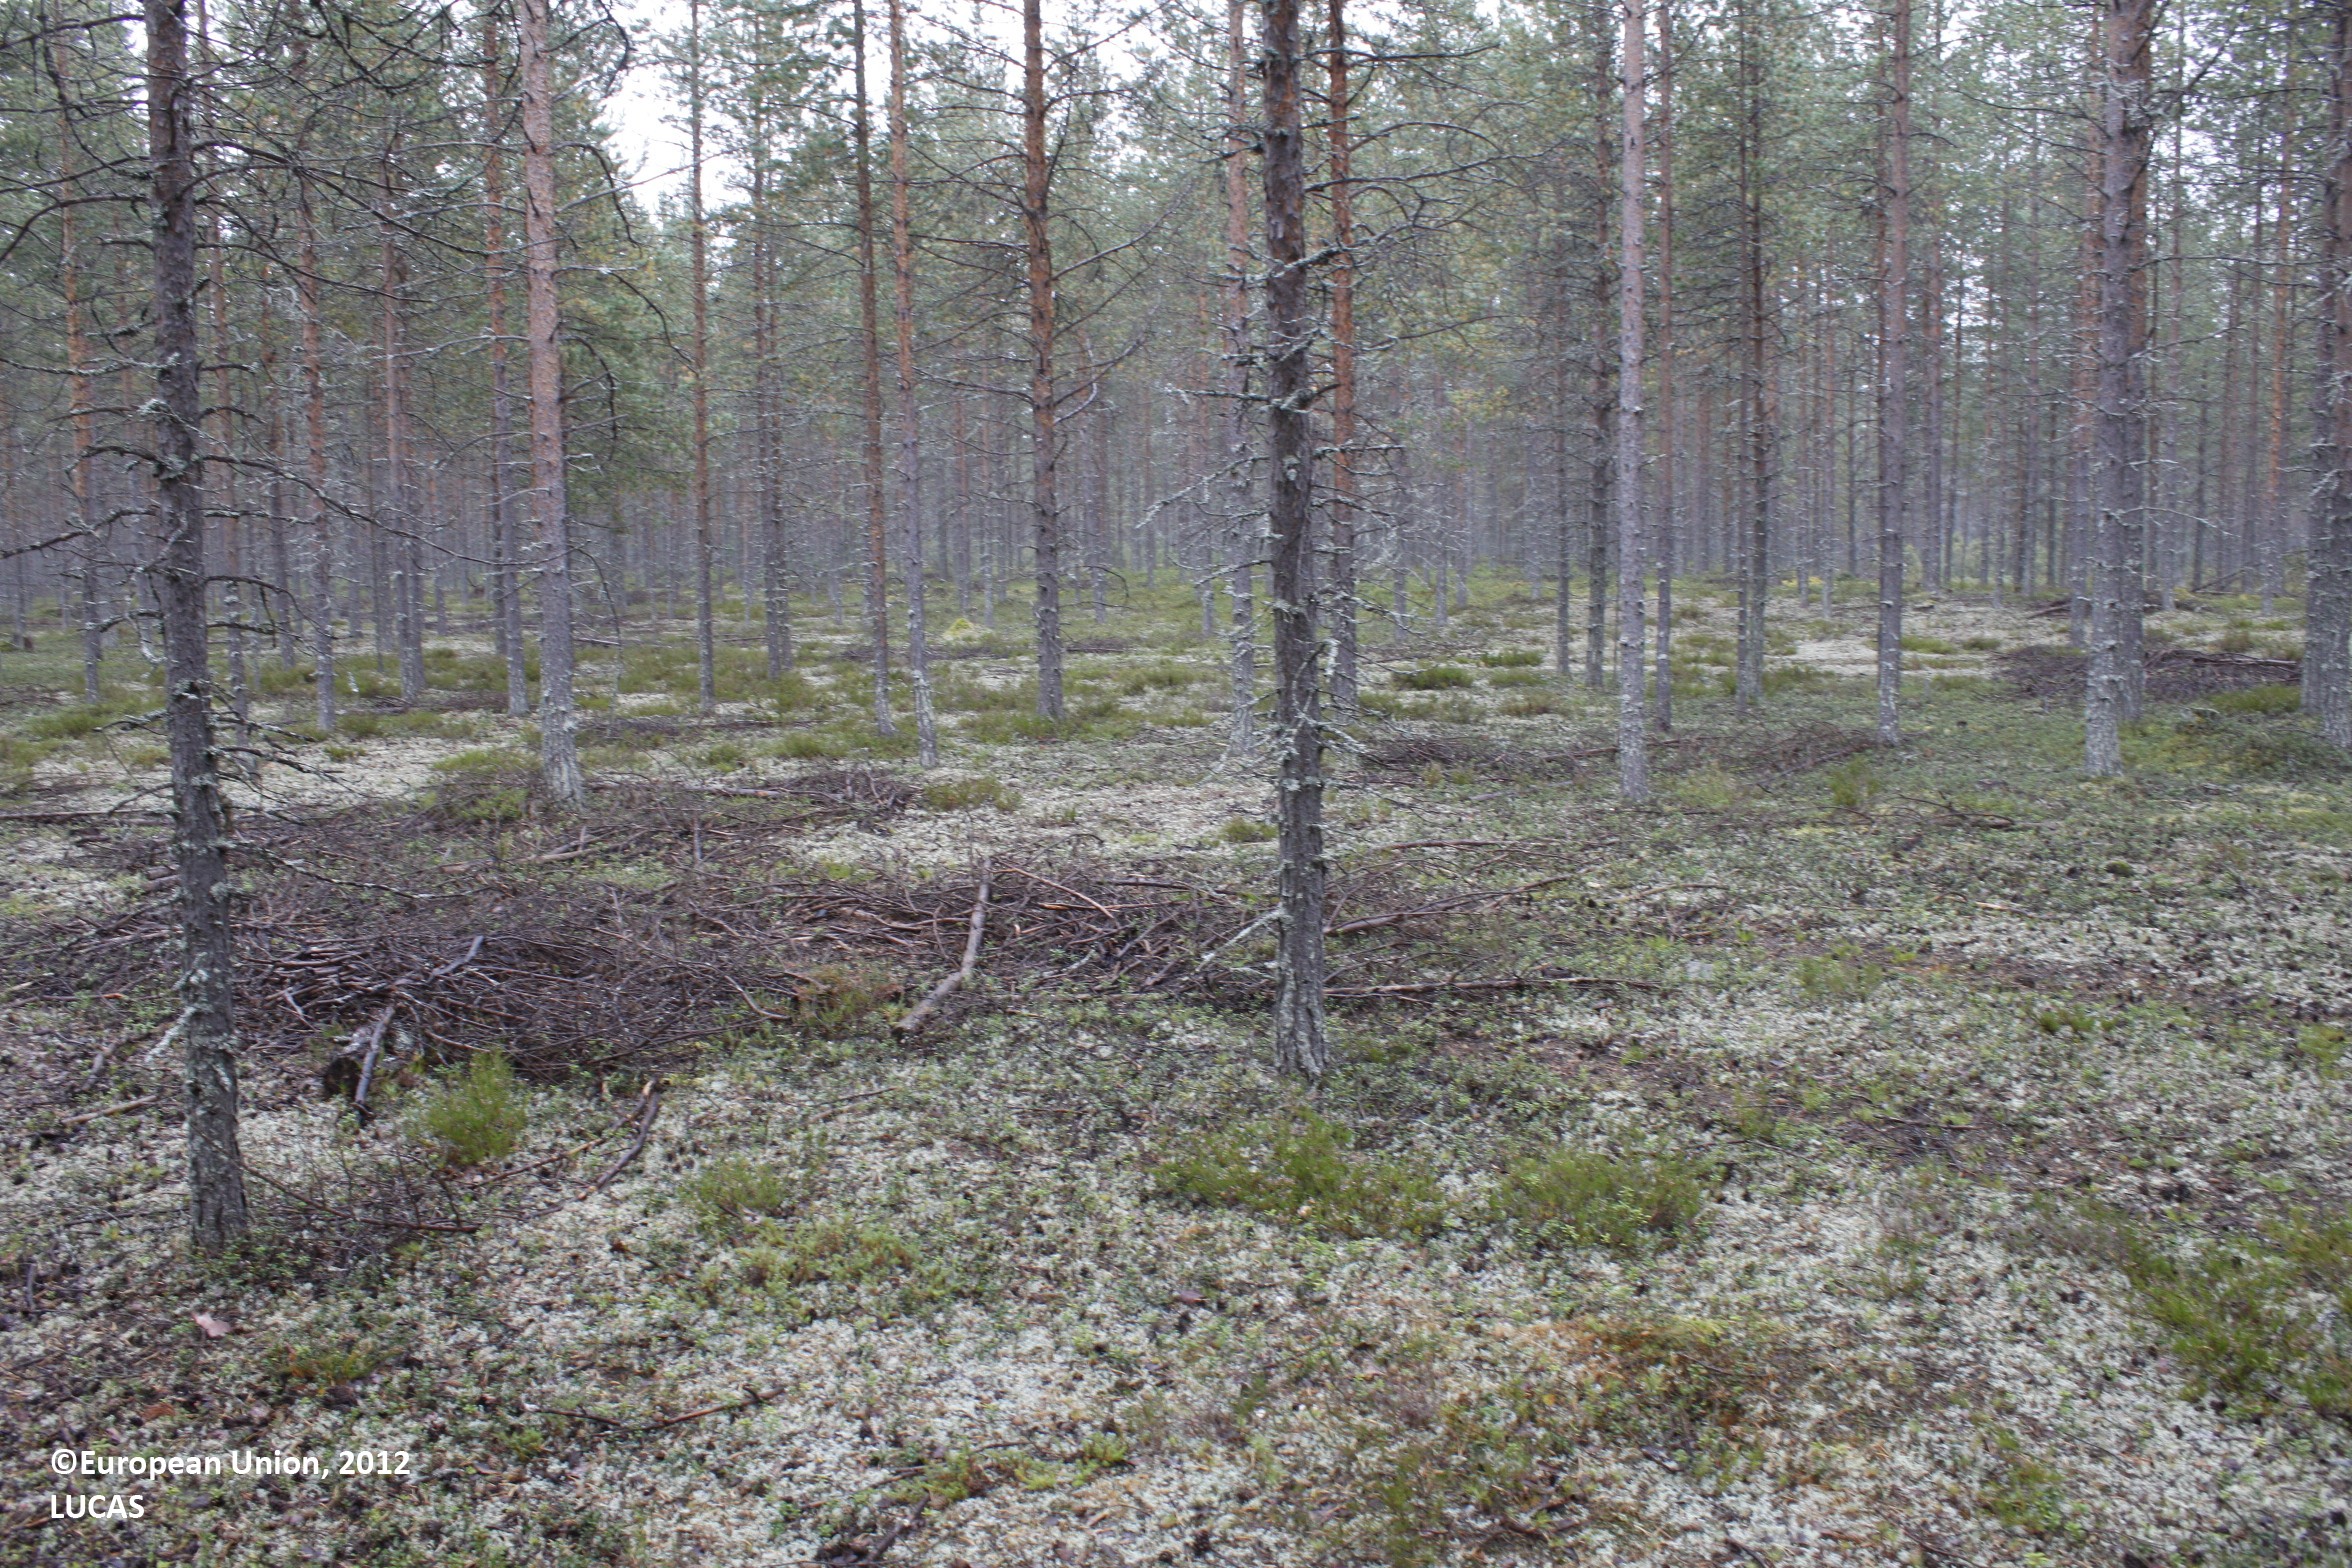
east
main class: Woodland
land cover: Pine dominated coniferous woodland
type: mire and swamp forests
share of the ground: 25 - 50 %
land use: Forestry
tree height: > 5 m
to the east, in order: Pine dominated coniferous woodland
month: September
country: FI
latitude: 65.3928
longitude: 26.9237
